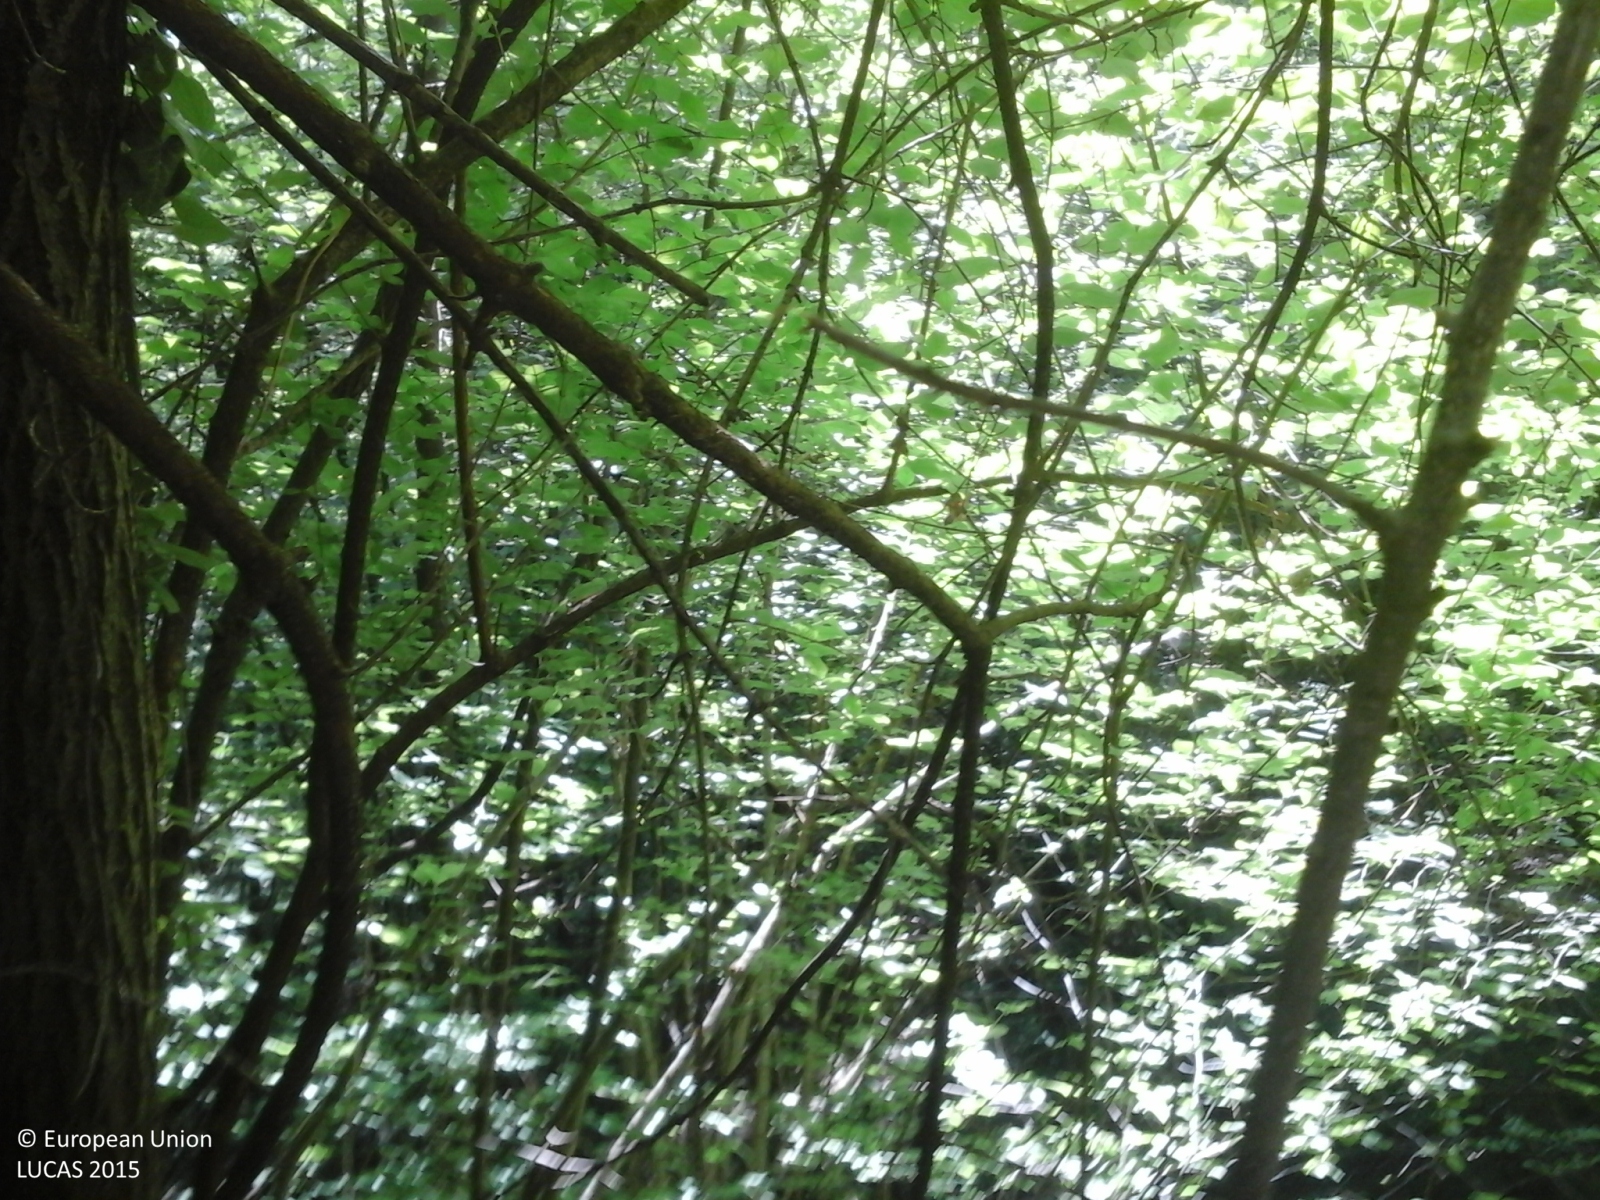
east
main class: Woodland
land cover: Broadleaved woodland
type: thermophilous deciduous forest
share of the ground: > 75 %
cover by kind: broadleaved forest trees 100 %
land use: Forestry
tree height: > 5 m
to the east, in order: Broadleaved woodland; Rivers and streams; Broadleaved woodland; Other mixed woodland; Grassland with sparse tree/shrub cover; Paved roads, cycling and walking lanes; Other mixed woodland
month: May
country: IT
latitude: 46.0592
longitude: 10.8906
